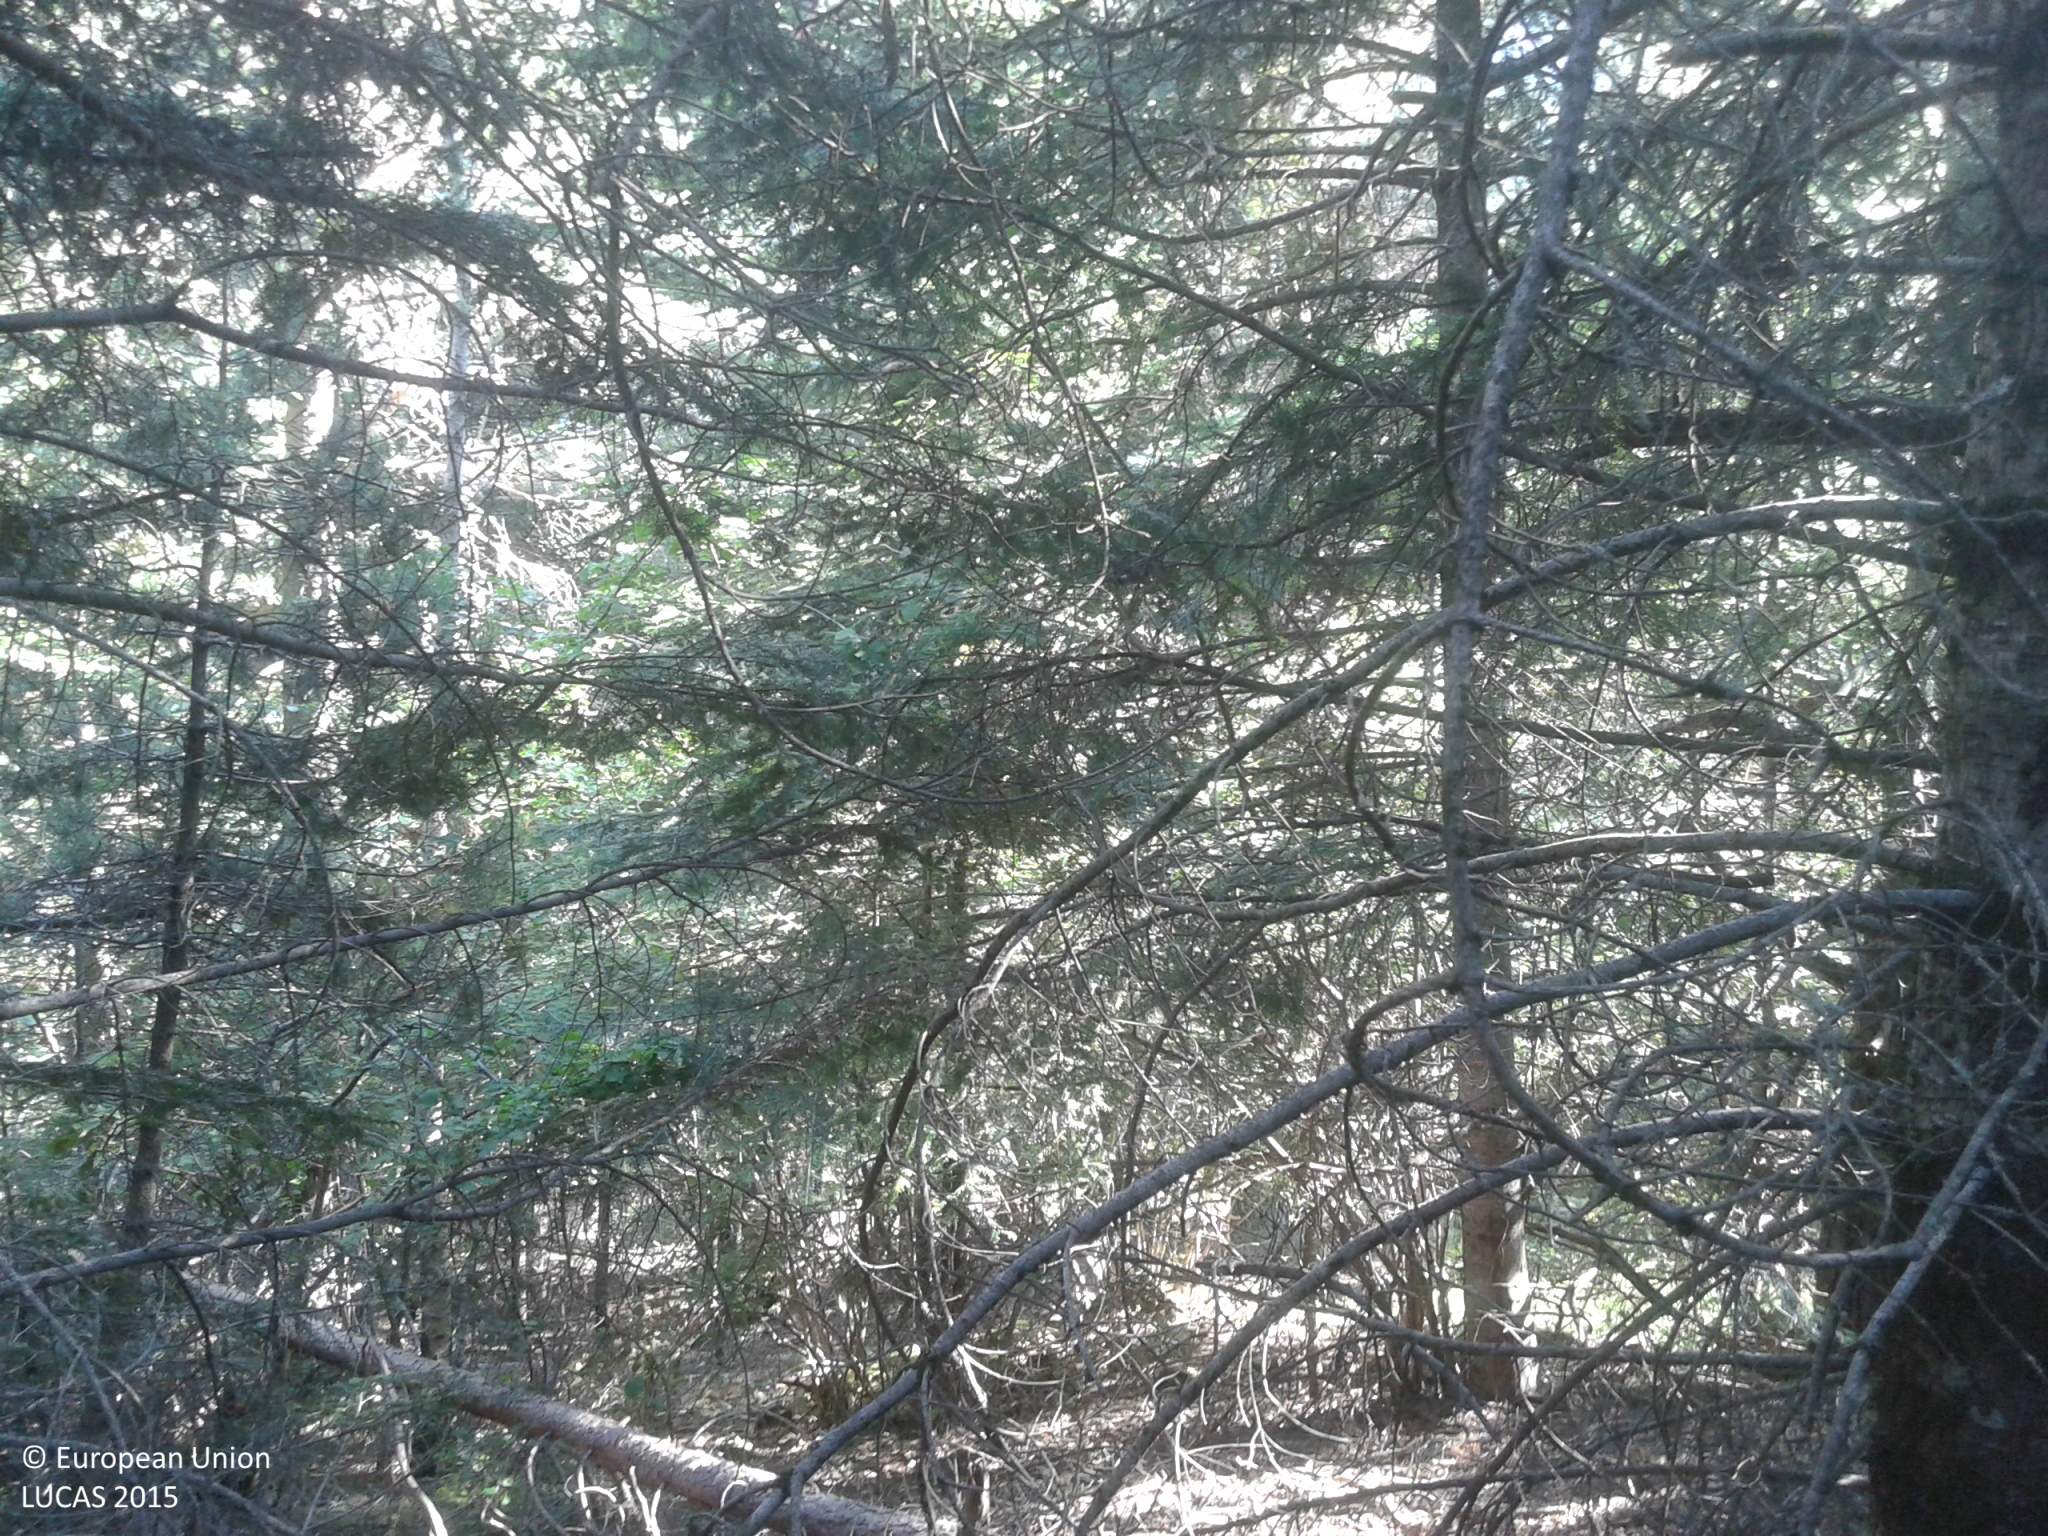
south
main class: Woodland
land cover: Pine dominated coniferous woodland
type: alpine coniferous forest
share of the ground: > 75 %
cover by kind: coniferous forest trees 90 %, broadleaved forest trees 5 %, herbaceous plants 5 %
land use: Semi-natural and natural areas not in use
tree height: > 5 m
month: July
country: ES
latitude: 42.5819
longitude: 1.0269
